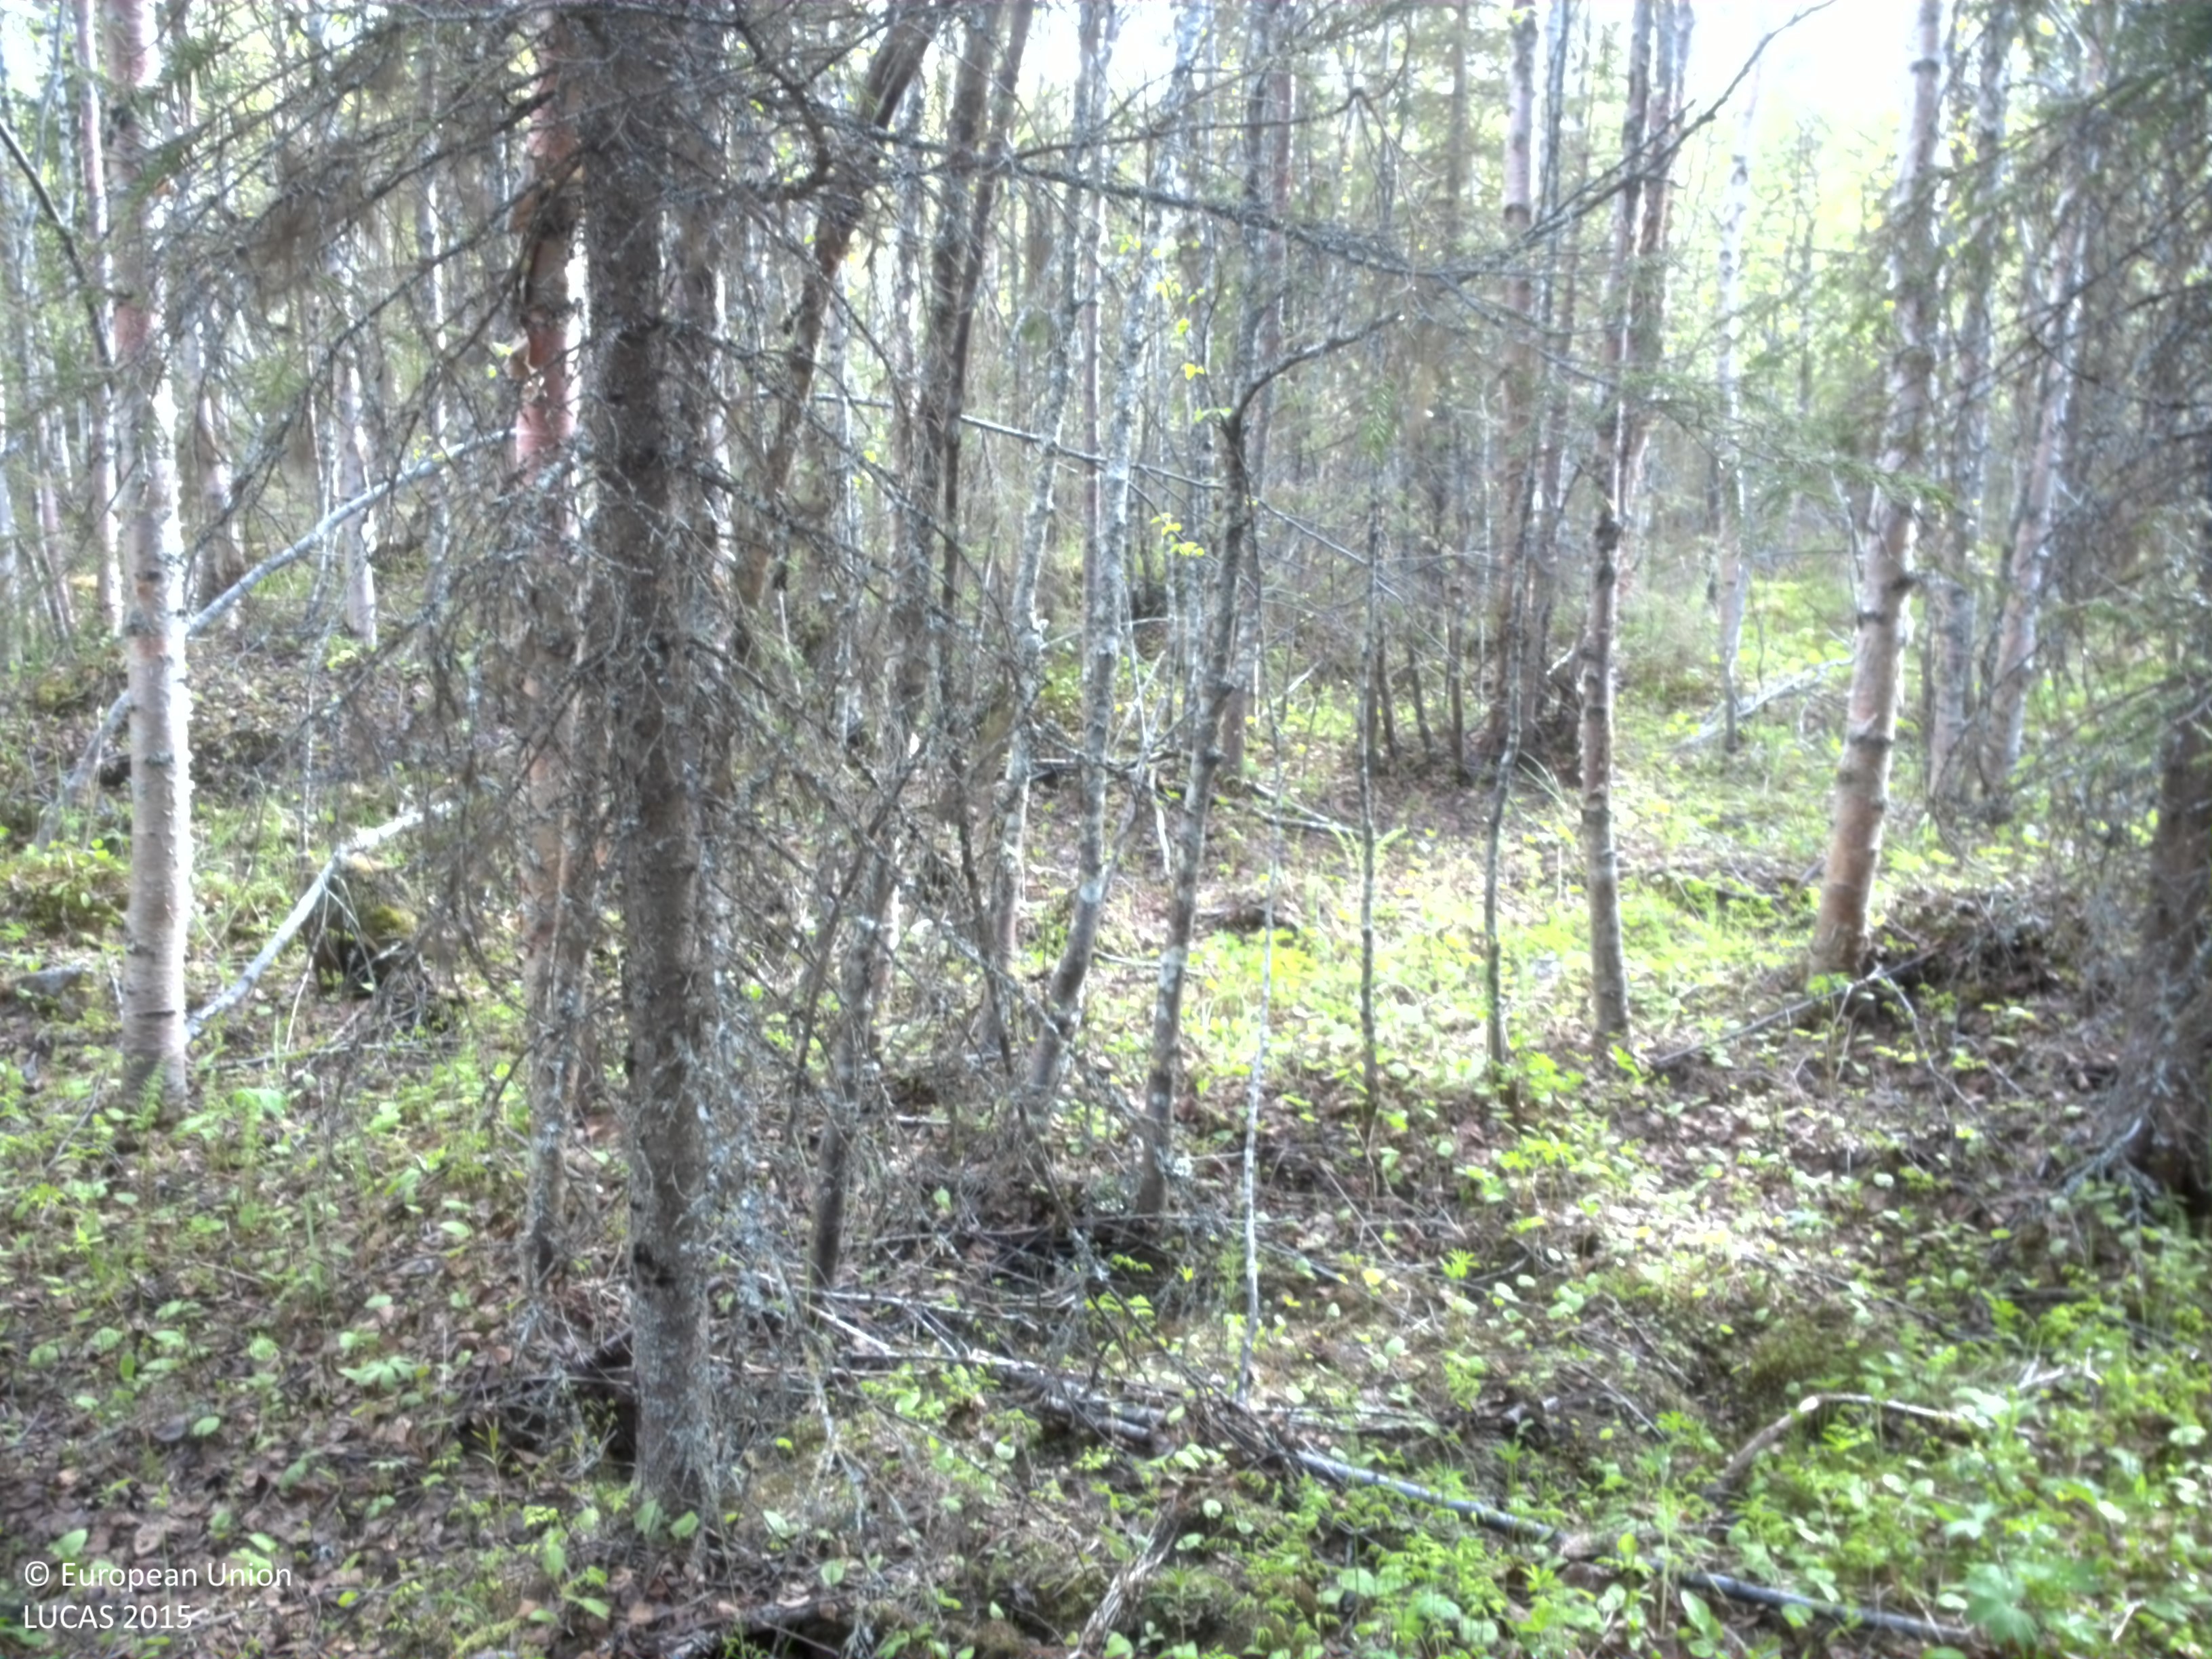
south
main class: Woodland
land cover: Spruce dominated mixed woodland
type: boreal forest
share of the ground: 50 - 75 %
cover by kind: coniferous forest trees 35 %, herbaceous plants 35 %, broadleaved forest trees 20 %, shrubs 5 %, lichens and mosses 5 %
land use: Forestry
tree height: > 5 m
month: June
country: SE
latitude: 67.0002
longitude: 22.0472
